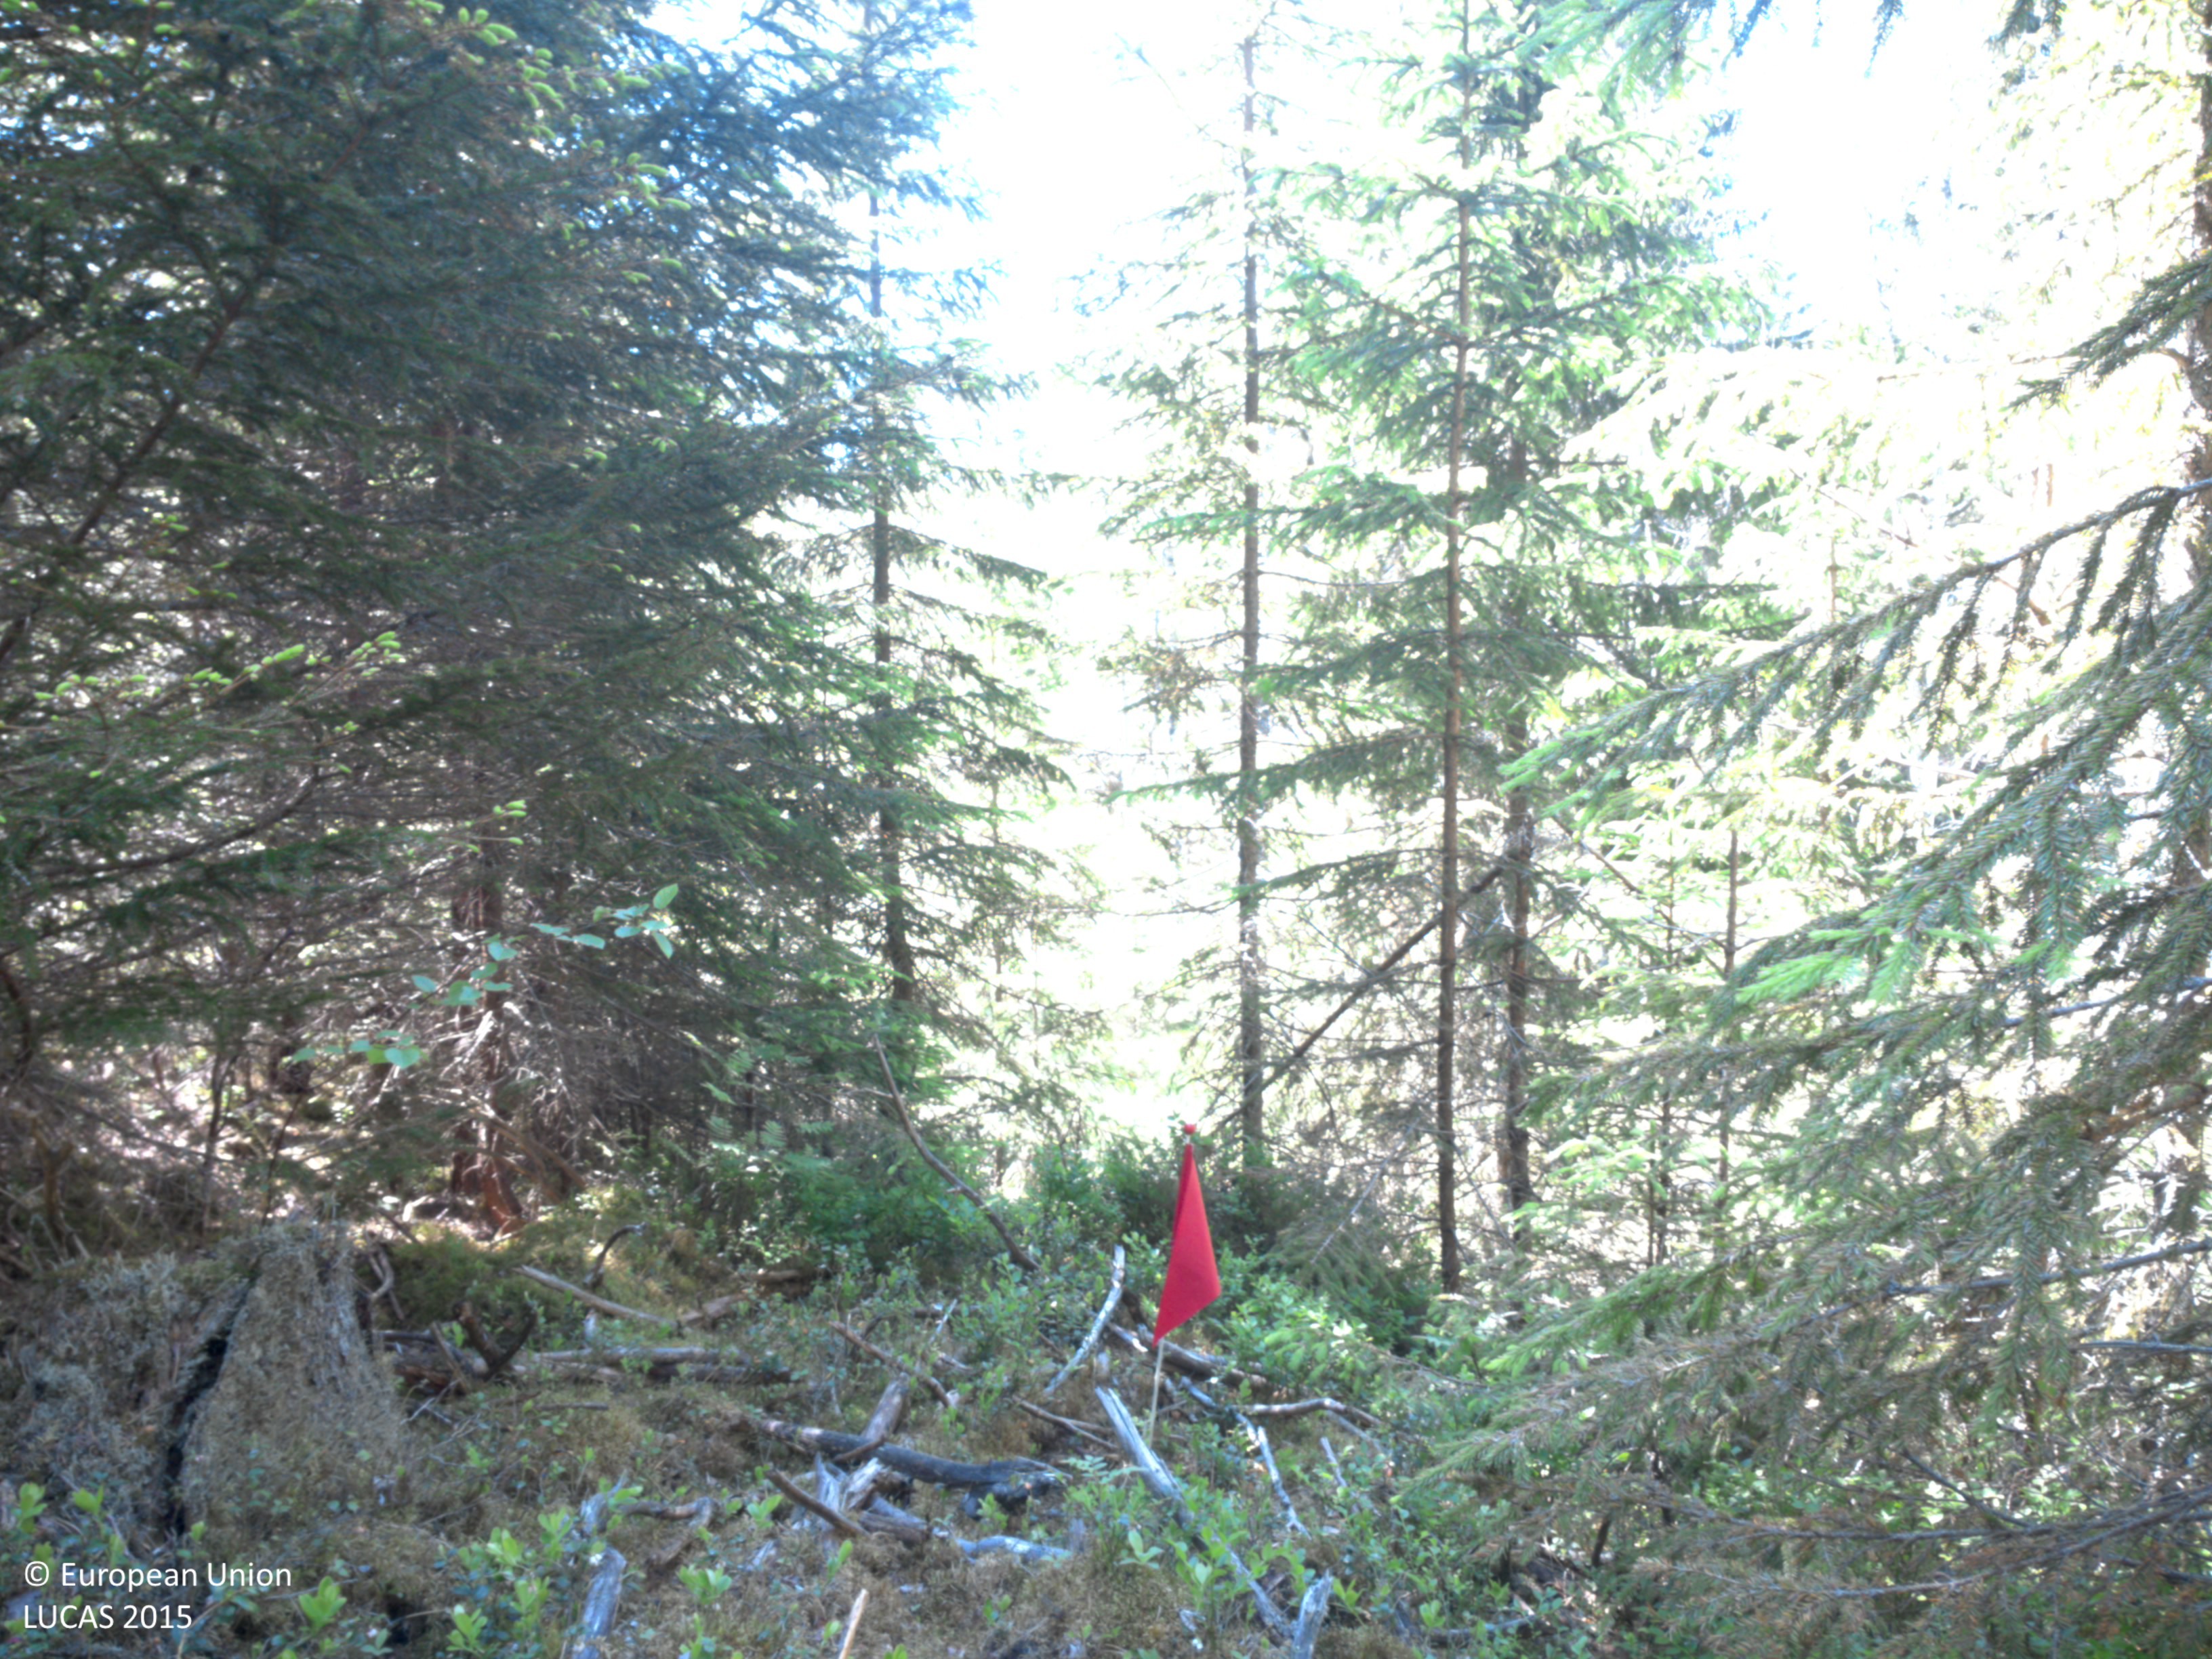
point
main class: Woodland
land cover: Spruce dominated coniferous woodland
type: boreal forest
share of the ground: 50 - 75 %
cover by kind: coniferous forest trees 55 %, lichens and mosses 30 %, shrubs 10 %, herbaceous plants 5 %
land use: Forestry
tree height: < 5 m
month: June
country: SE
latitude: 59.0308
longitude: 12.1032
